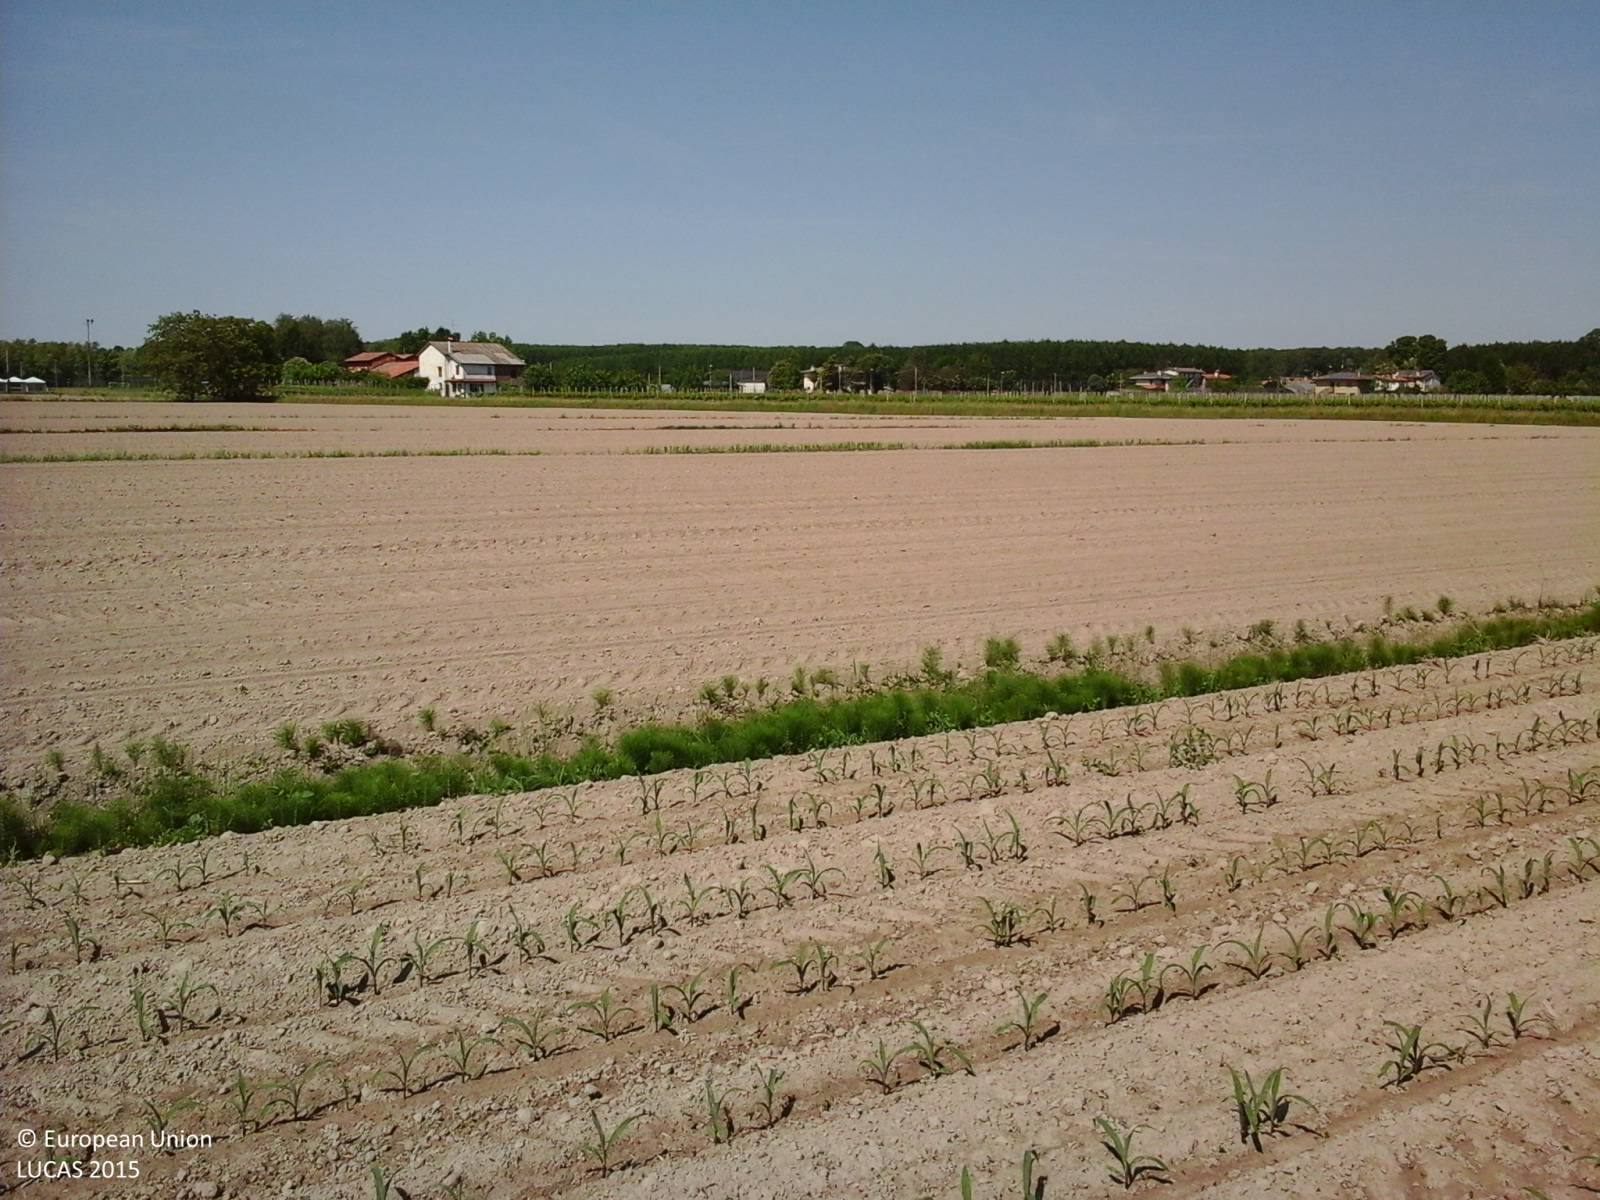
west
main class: Cropland
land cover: Maize
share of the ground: < 10 %
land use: Agriculture (excluding fallow land and kitchen gardens)
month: May
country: IT
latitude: 45.7498
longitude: 13.0169
